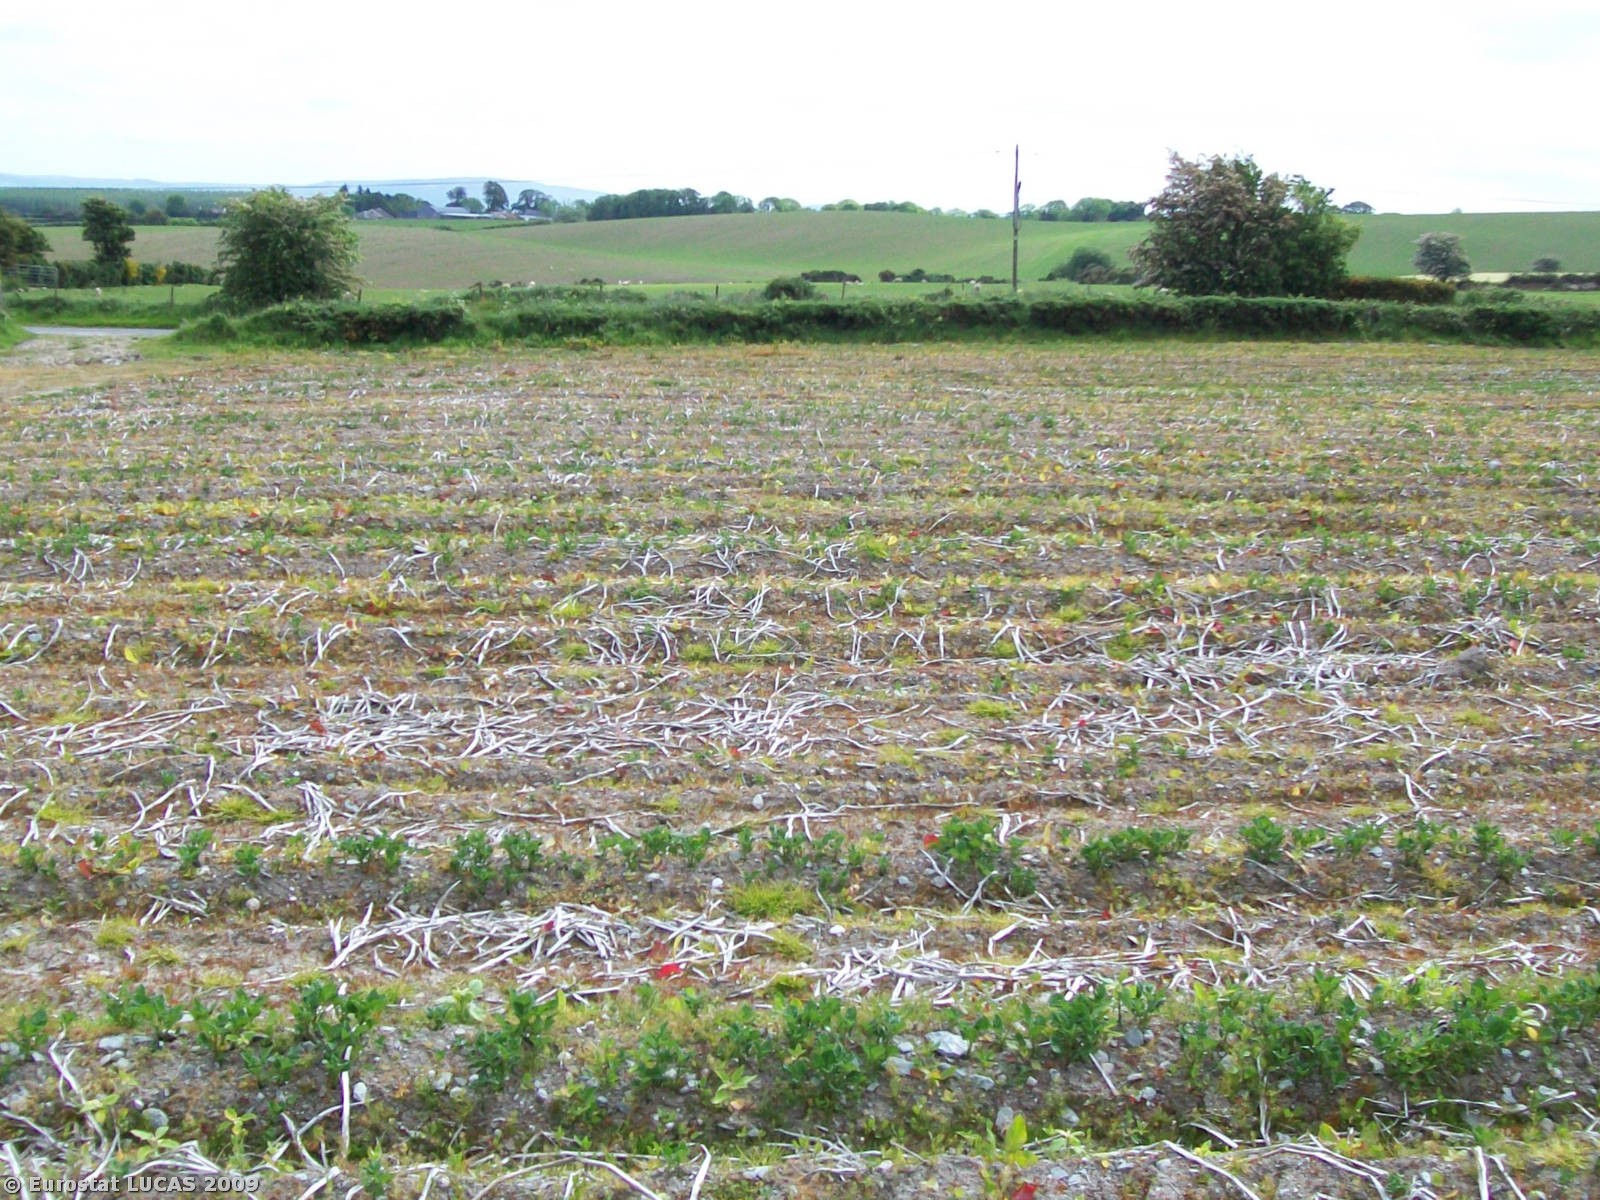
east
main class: Cropland
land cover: Potatoes
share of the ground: > 75 %
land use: Agriculture (excluding fallow land and kitchen gardens)
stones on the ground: < 10 %
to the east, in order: Potatoes; Managed hedges; Paved roads, cycling and walking lanes; Managed hedges; Electric lines; Grassland without tree/shrub cover
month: June
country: GB
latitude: 55.0289
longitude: -7.0831
